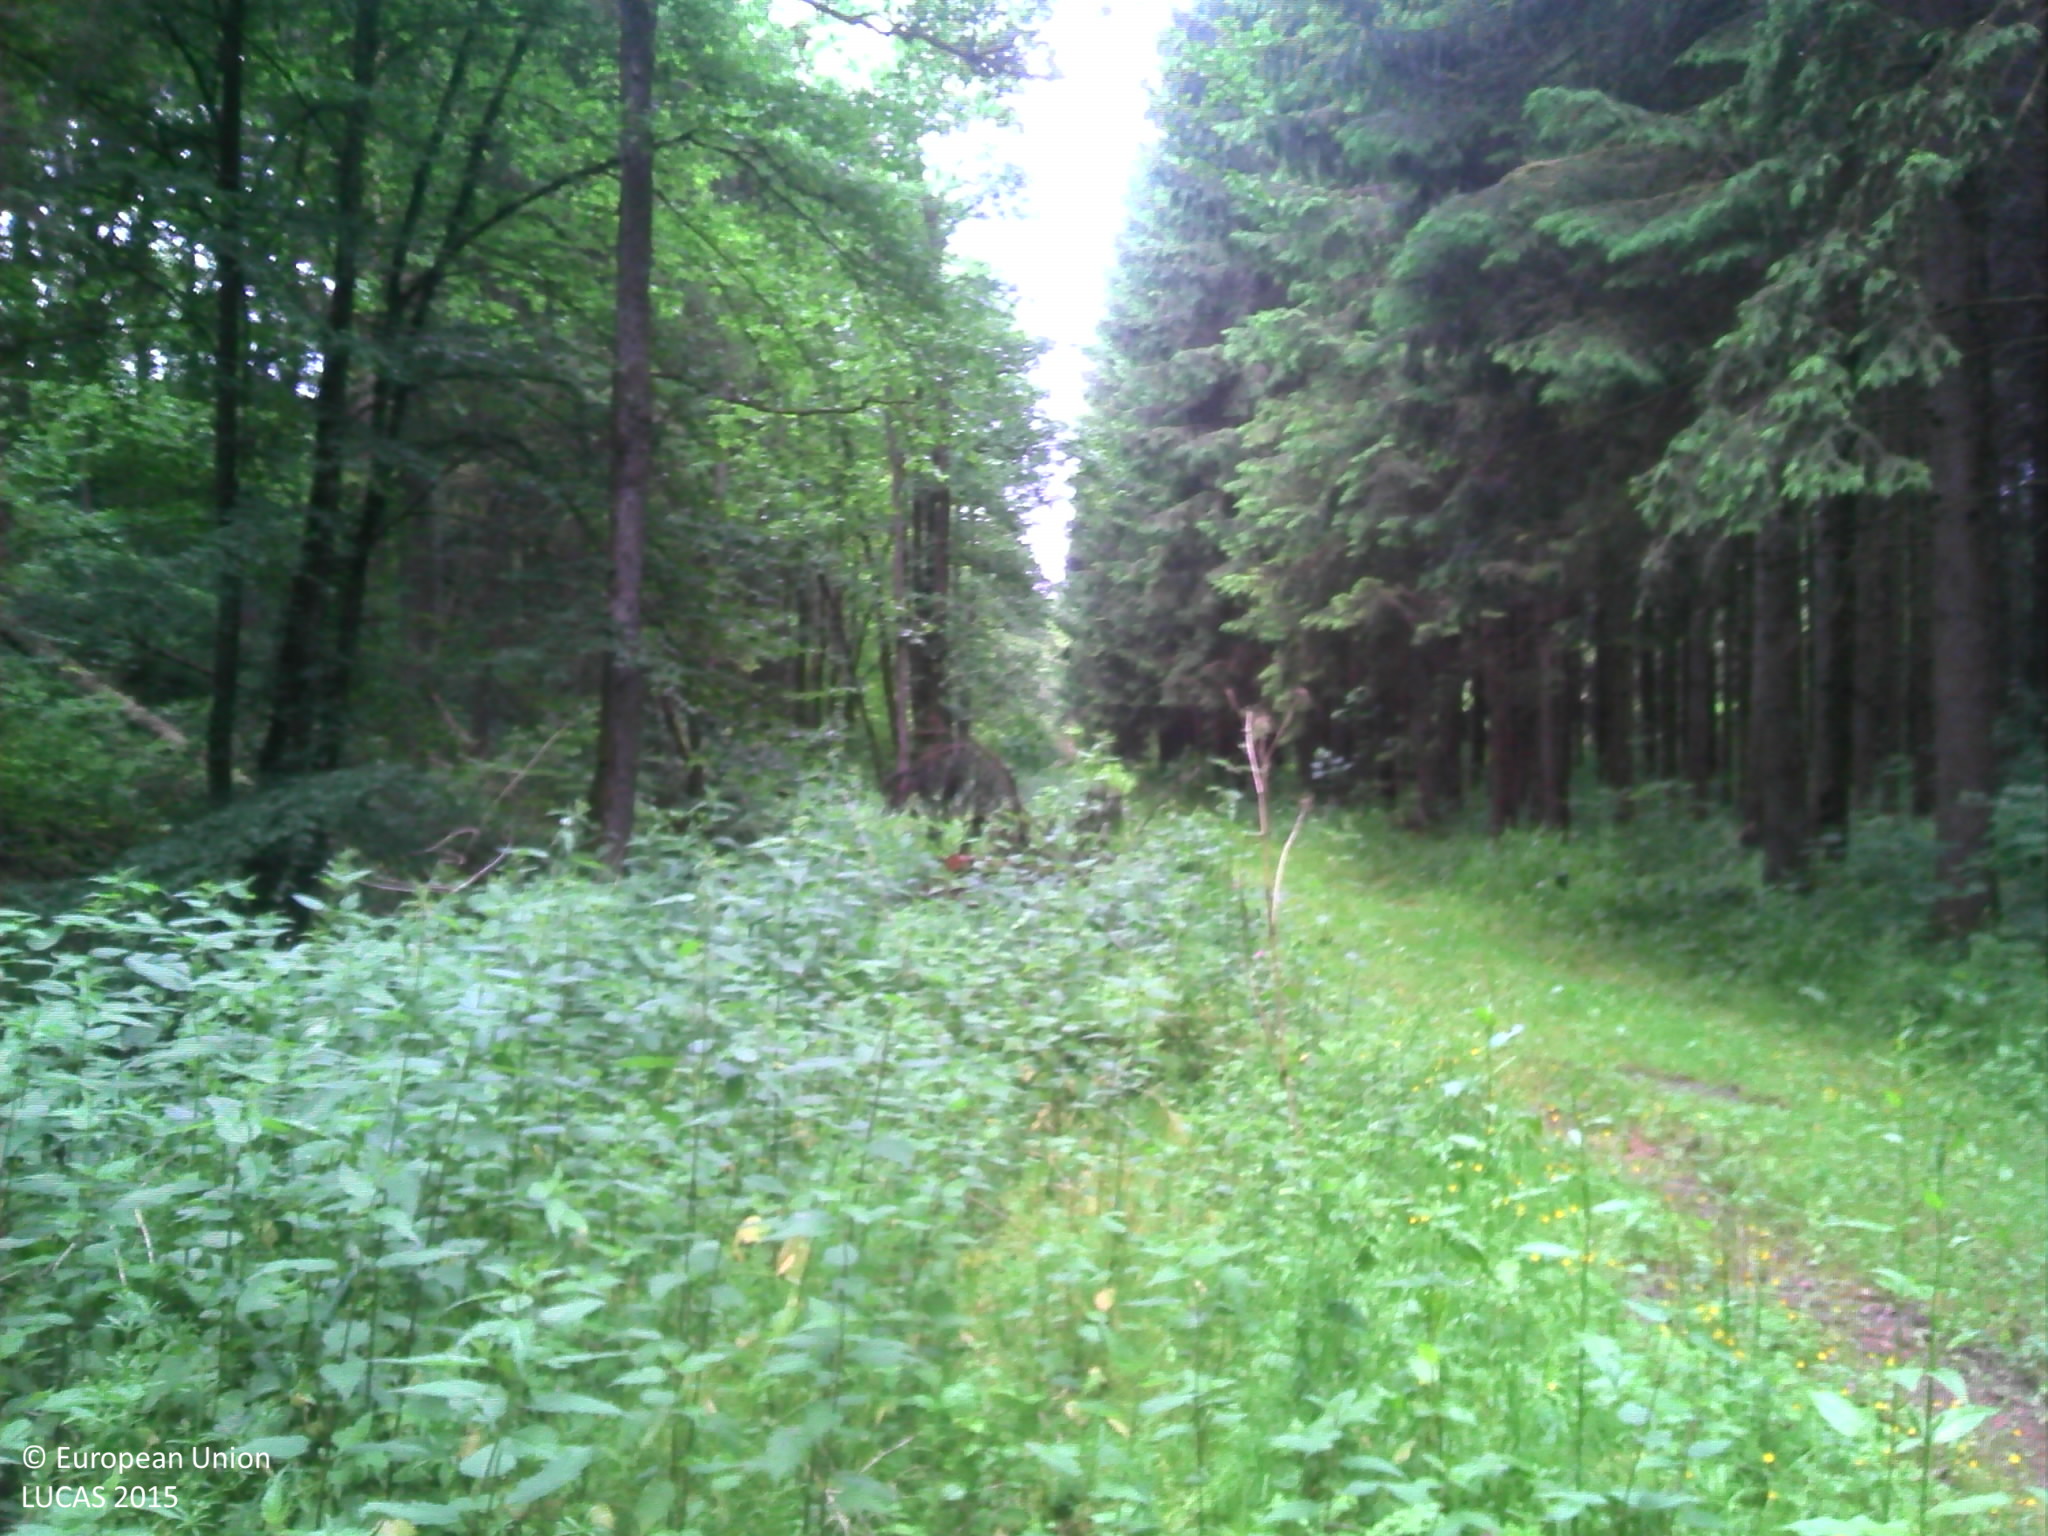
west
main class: Grassland
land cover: Spontaneously vegetated surfaces
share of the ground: > 75 %
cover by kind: herbaceous plants 100 %
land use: Forestry
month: June
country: BE
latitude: 50.2430
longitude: 4.7383
